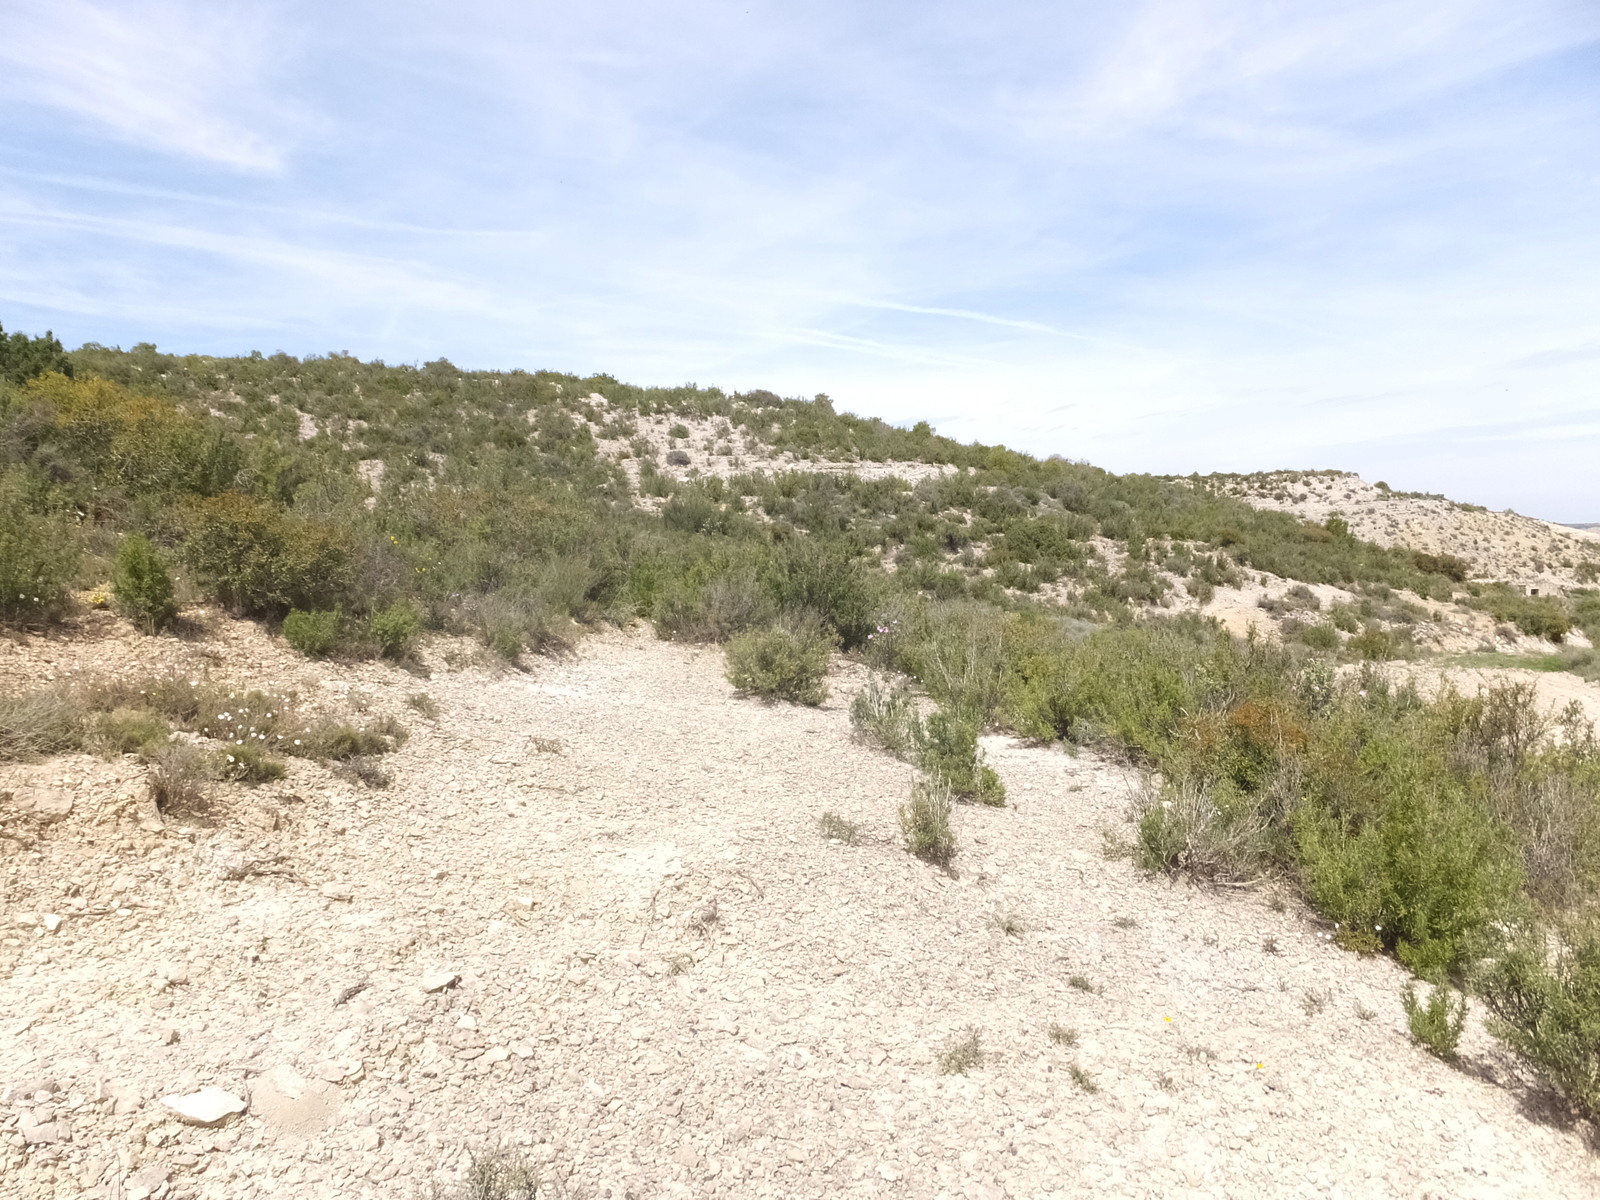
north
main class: Shrubland
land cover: Shrubland with sparse tree cover
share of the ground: > 75 %
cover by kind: shrubs 50 %, unconsolidated bare surface 25 %, herbaceous plants 20 %, broadleaved forest trees 5 %
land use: Semi-natural and natural areas not in use
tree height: < 5 m
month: April
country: ES
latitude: 41.5869
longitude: -0.2490
